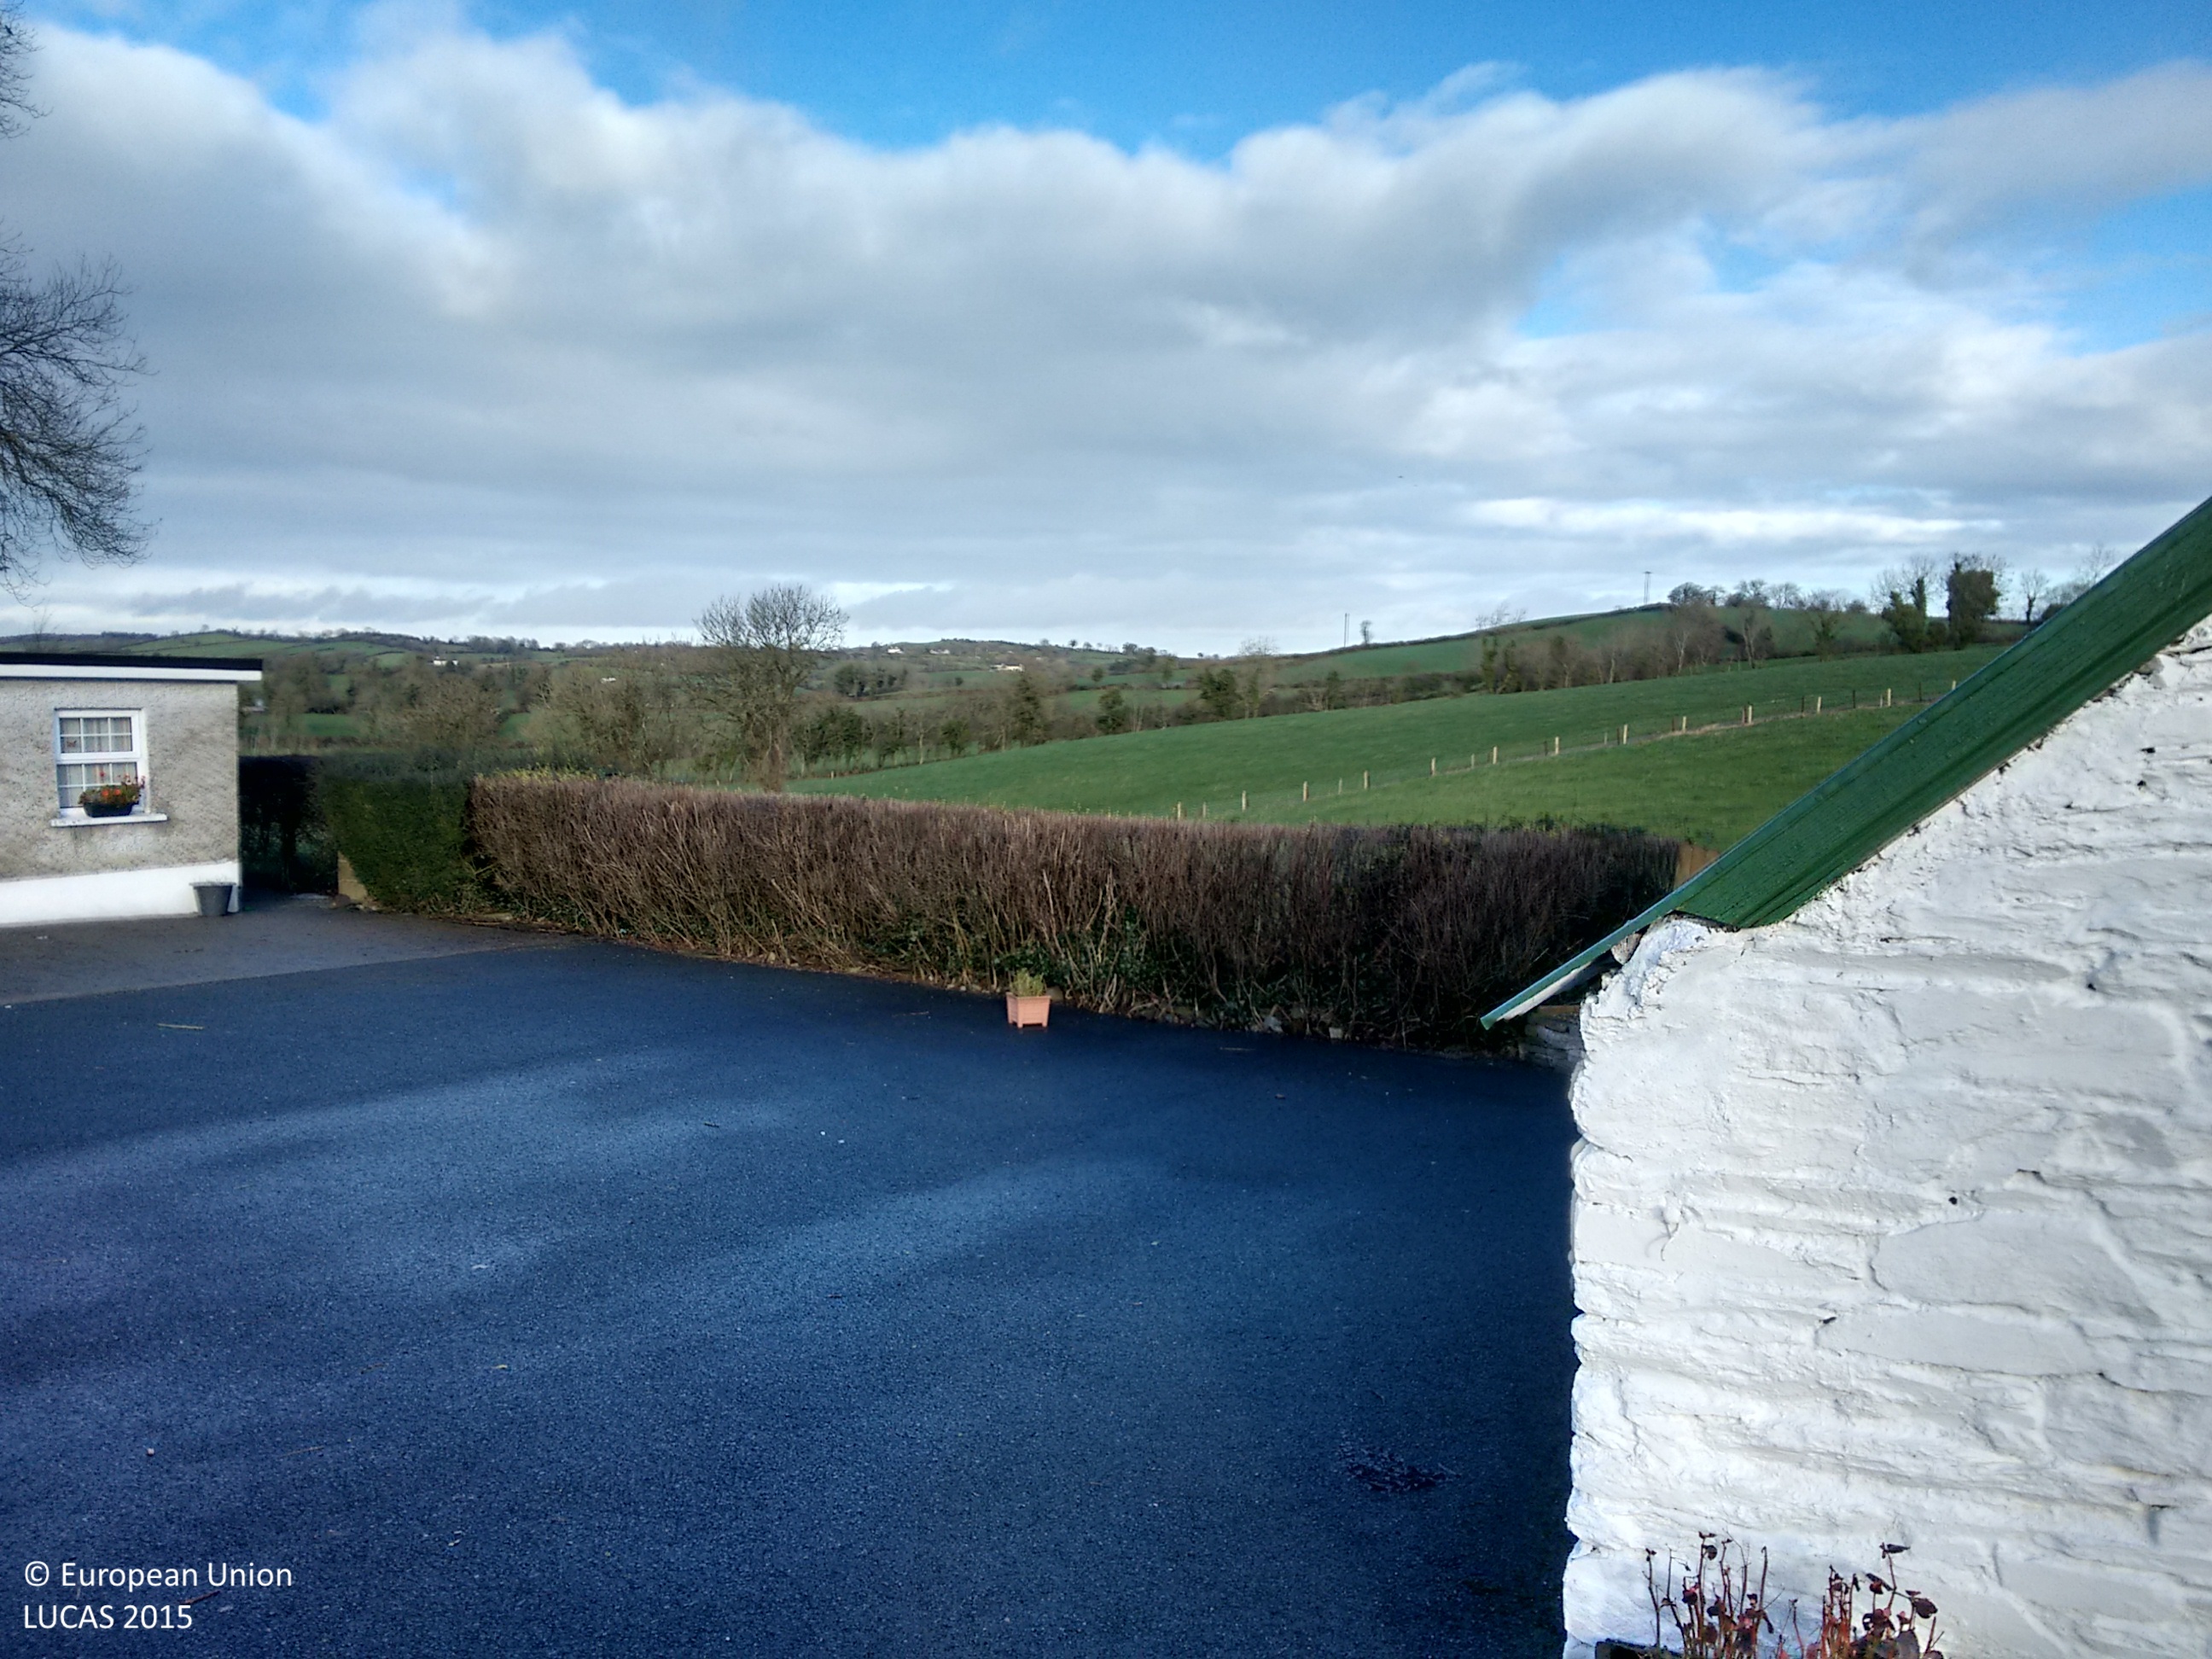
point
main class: Grassland
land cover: Grassland without tree/shrub cover
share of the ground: > 75 %
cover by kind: herbaceous plants 100 %
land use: Agriculture (excluding fallow land and kitchen gardens)
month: December
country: IE
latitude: 53.9425
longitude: -6.8173
